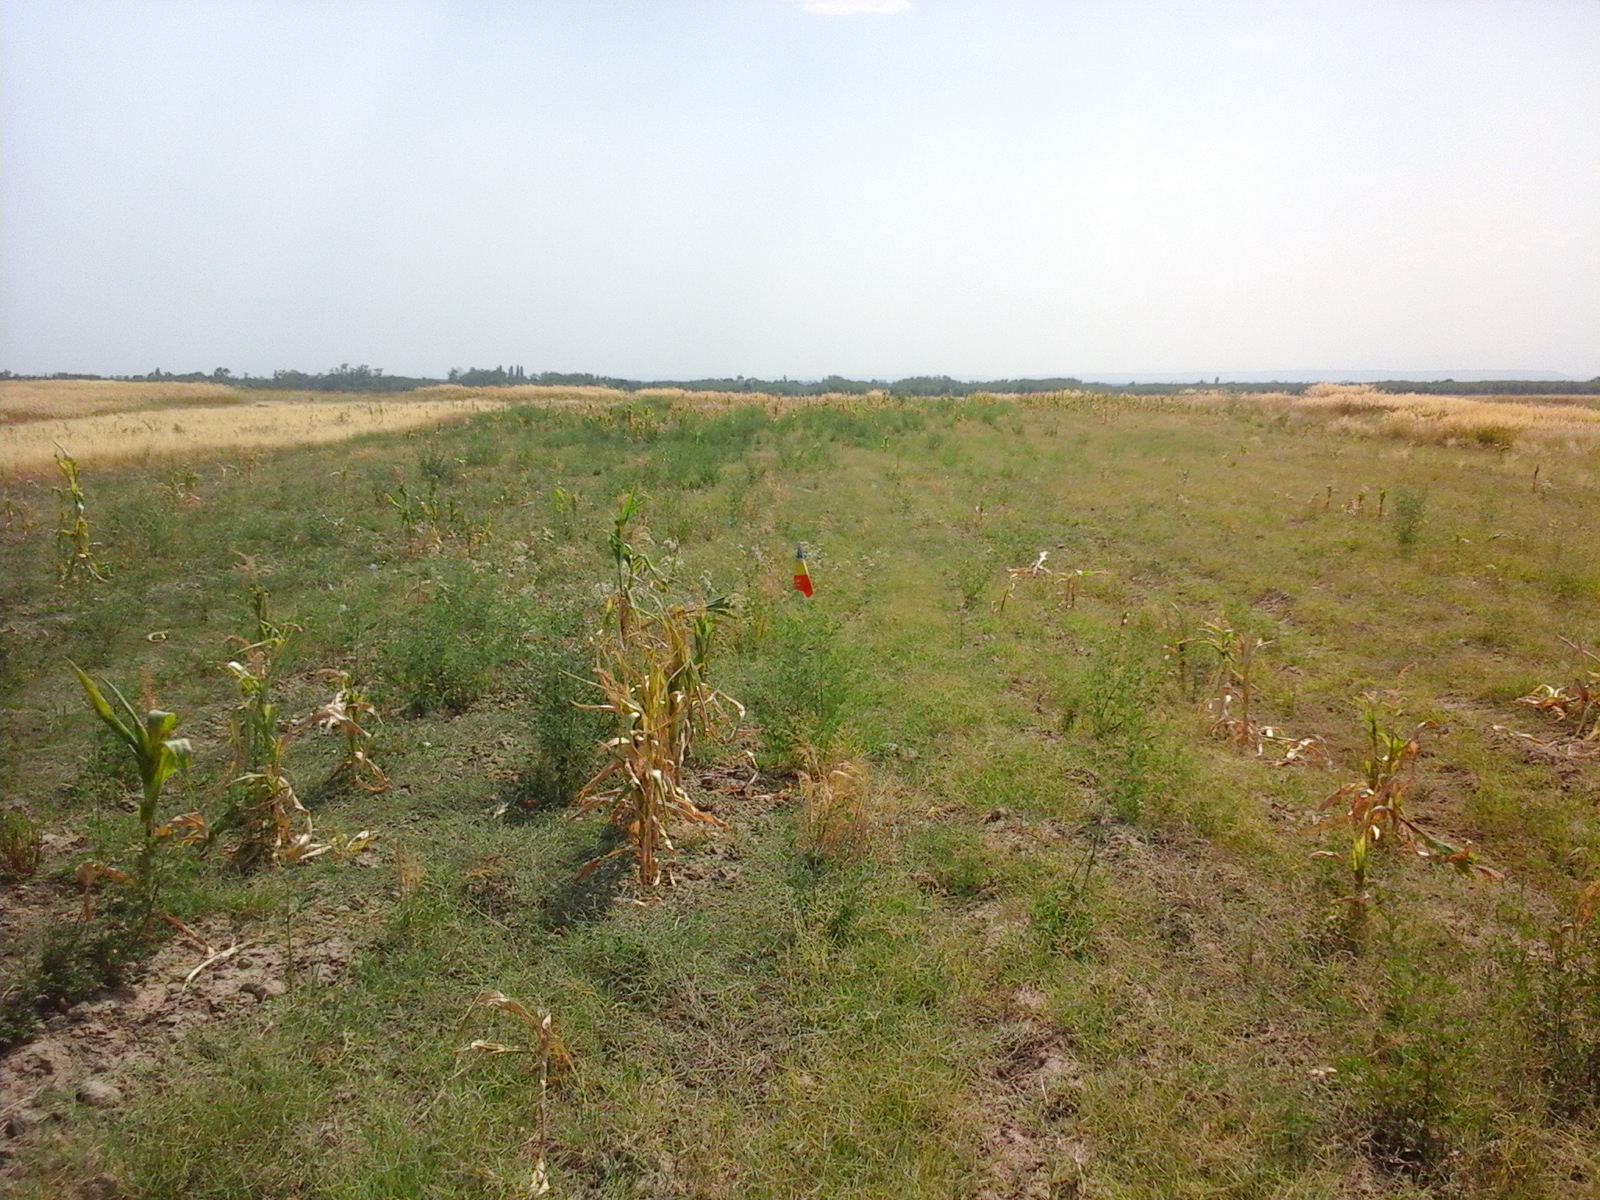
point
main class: Grassland
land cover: Spontaneously vegetated surfaces
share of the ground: > 75 %
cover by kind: herbaceous plants 100 %
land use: Fallow land
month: August
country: RO
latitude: 44.4815
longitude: 22.6765
